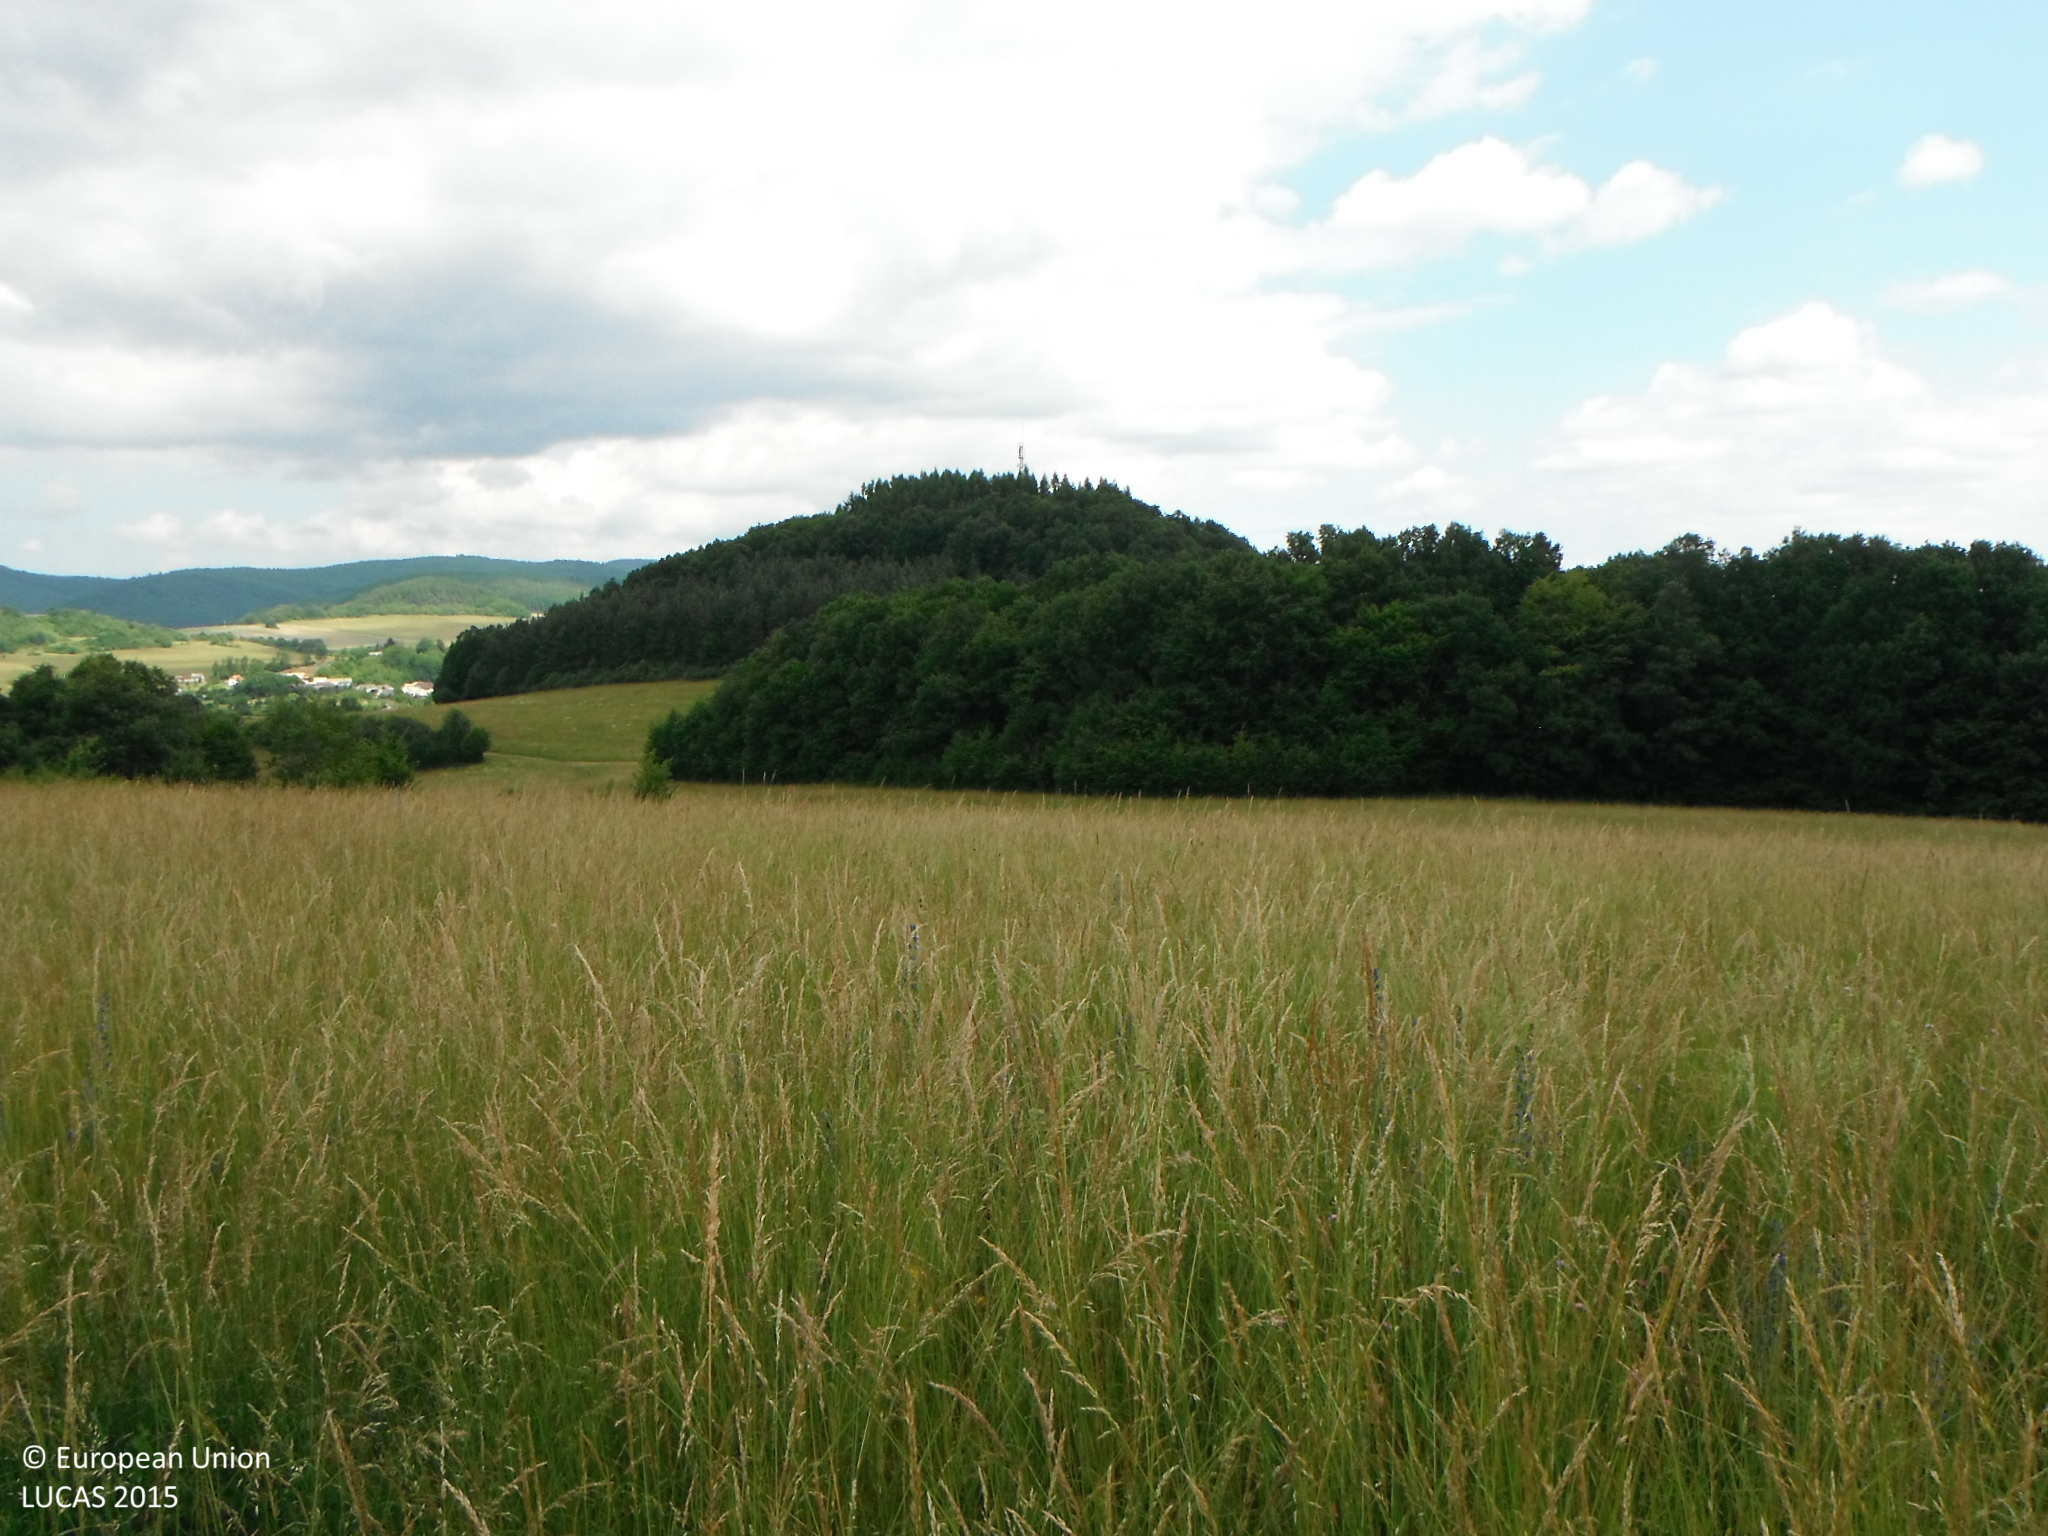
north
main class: Grassland
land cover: Grassland without tree/shrub cover
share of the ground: > 75 %
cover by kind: herbaceous plants 100 %
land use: Agriculture (excluding fallow land and kitchen gardens)
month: June
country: SK
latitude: 48.5939
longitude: 19.0377
